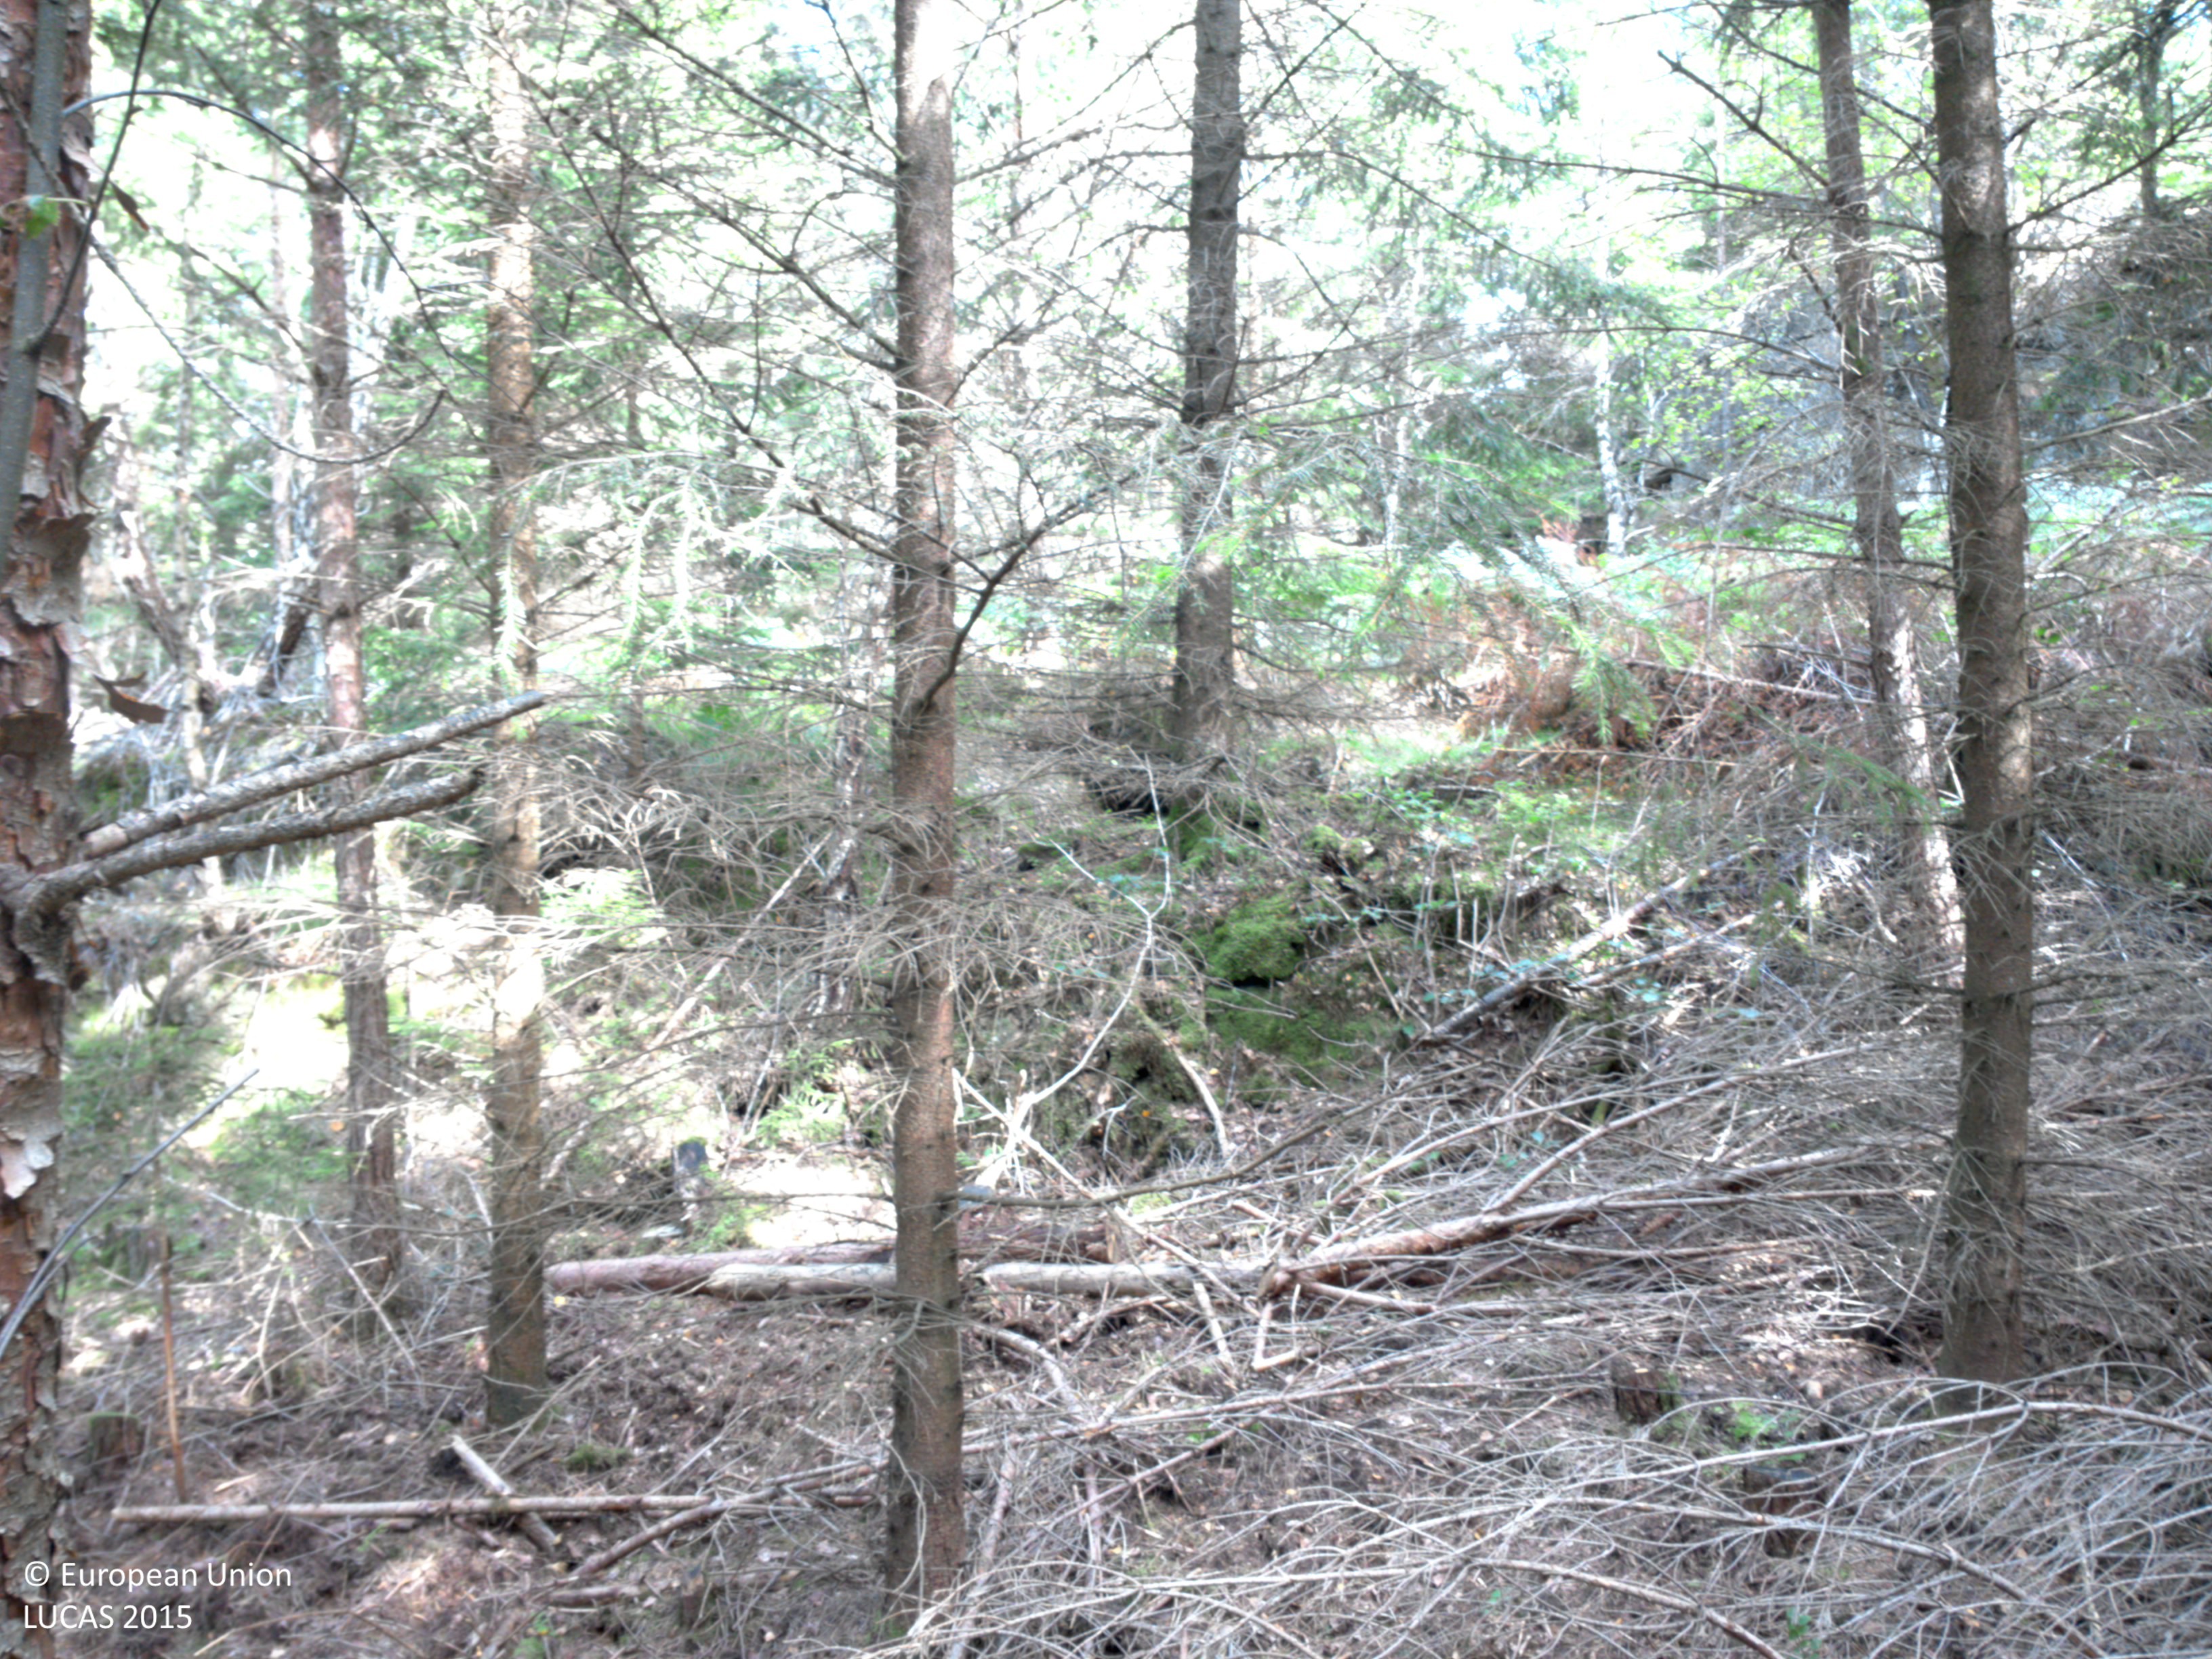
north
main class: Woodland
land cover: Other coniferous woodland
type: boreal forest
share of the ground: > 75 %
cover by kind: coniferous forest trees 90 %, shrubs 5 %, lichens and mosses 5 %
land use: Forestry
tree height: > 5 m
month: August
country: SE
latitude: 58.0076
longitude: 11.9426
